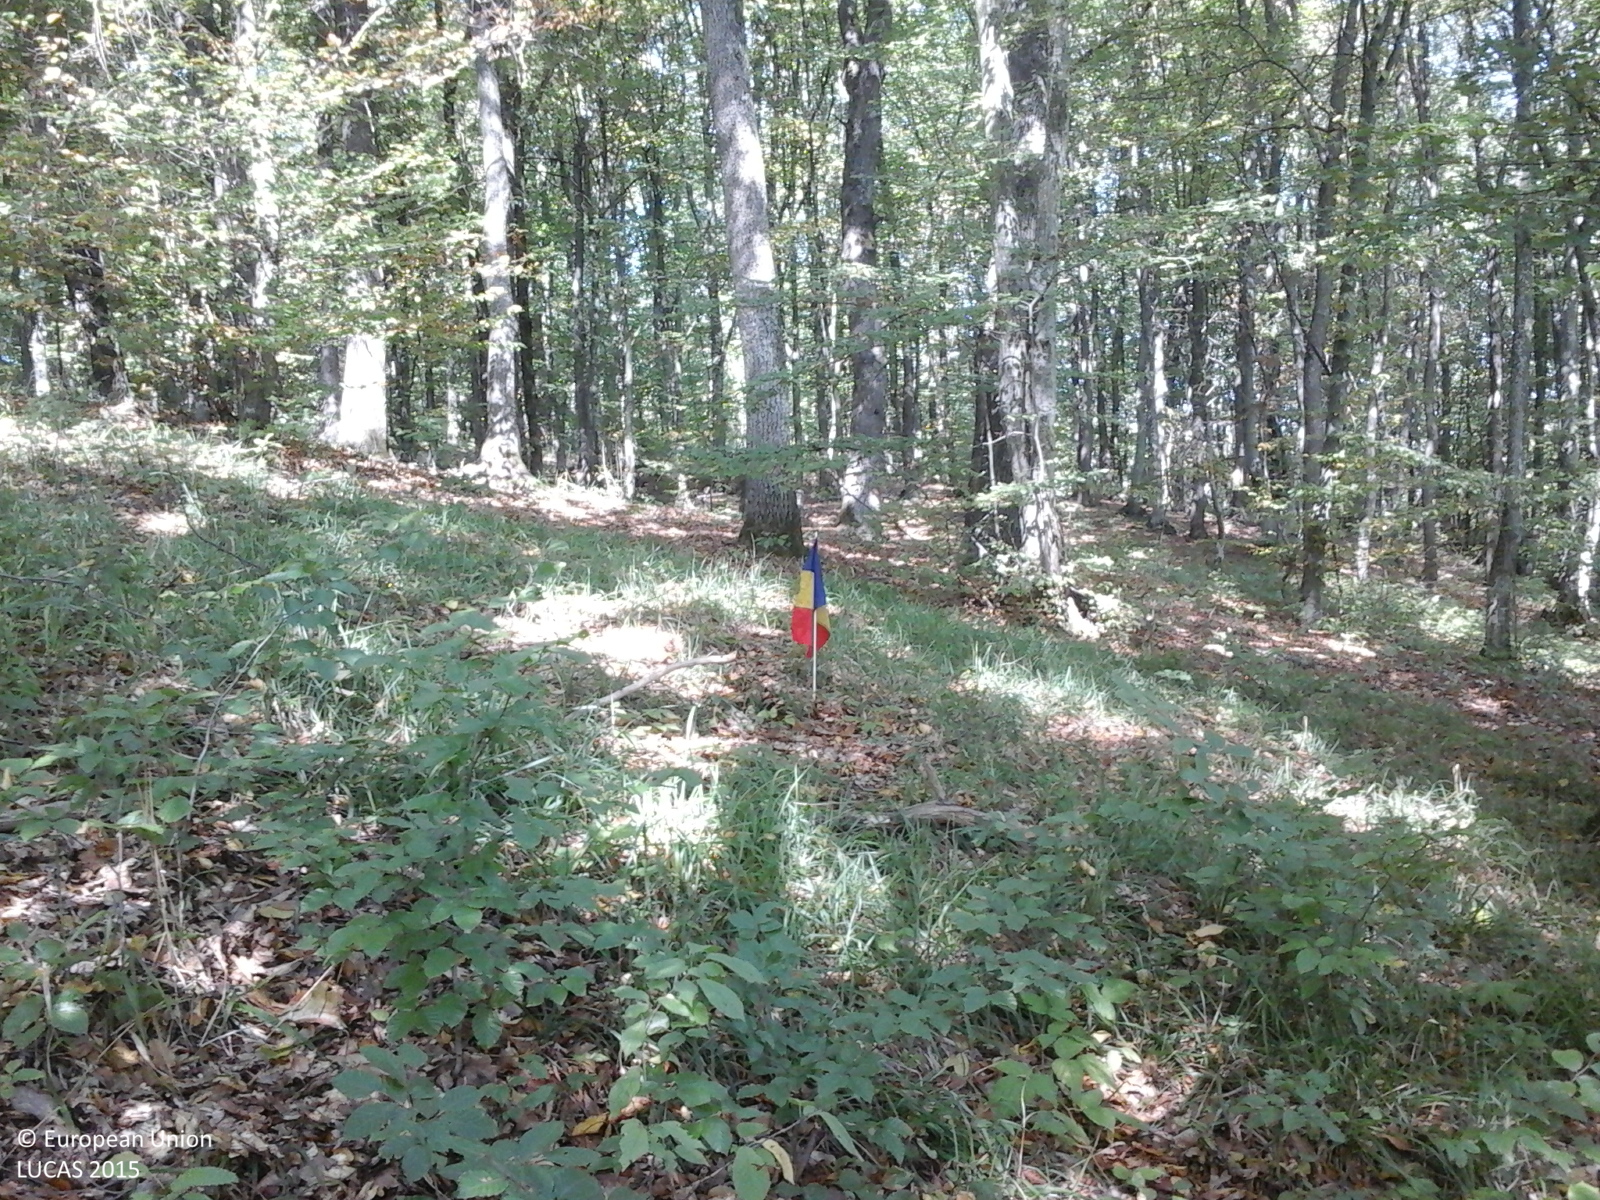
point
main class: Woodland
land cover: Broadleaved woodland
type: beech forest
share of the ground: > 75 %
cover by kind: broadleaved forest trees 100 %
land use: Forestry
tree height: > 5 m
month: September
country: RO
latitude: 47.3429
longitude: 23.4265
